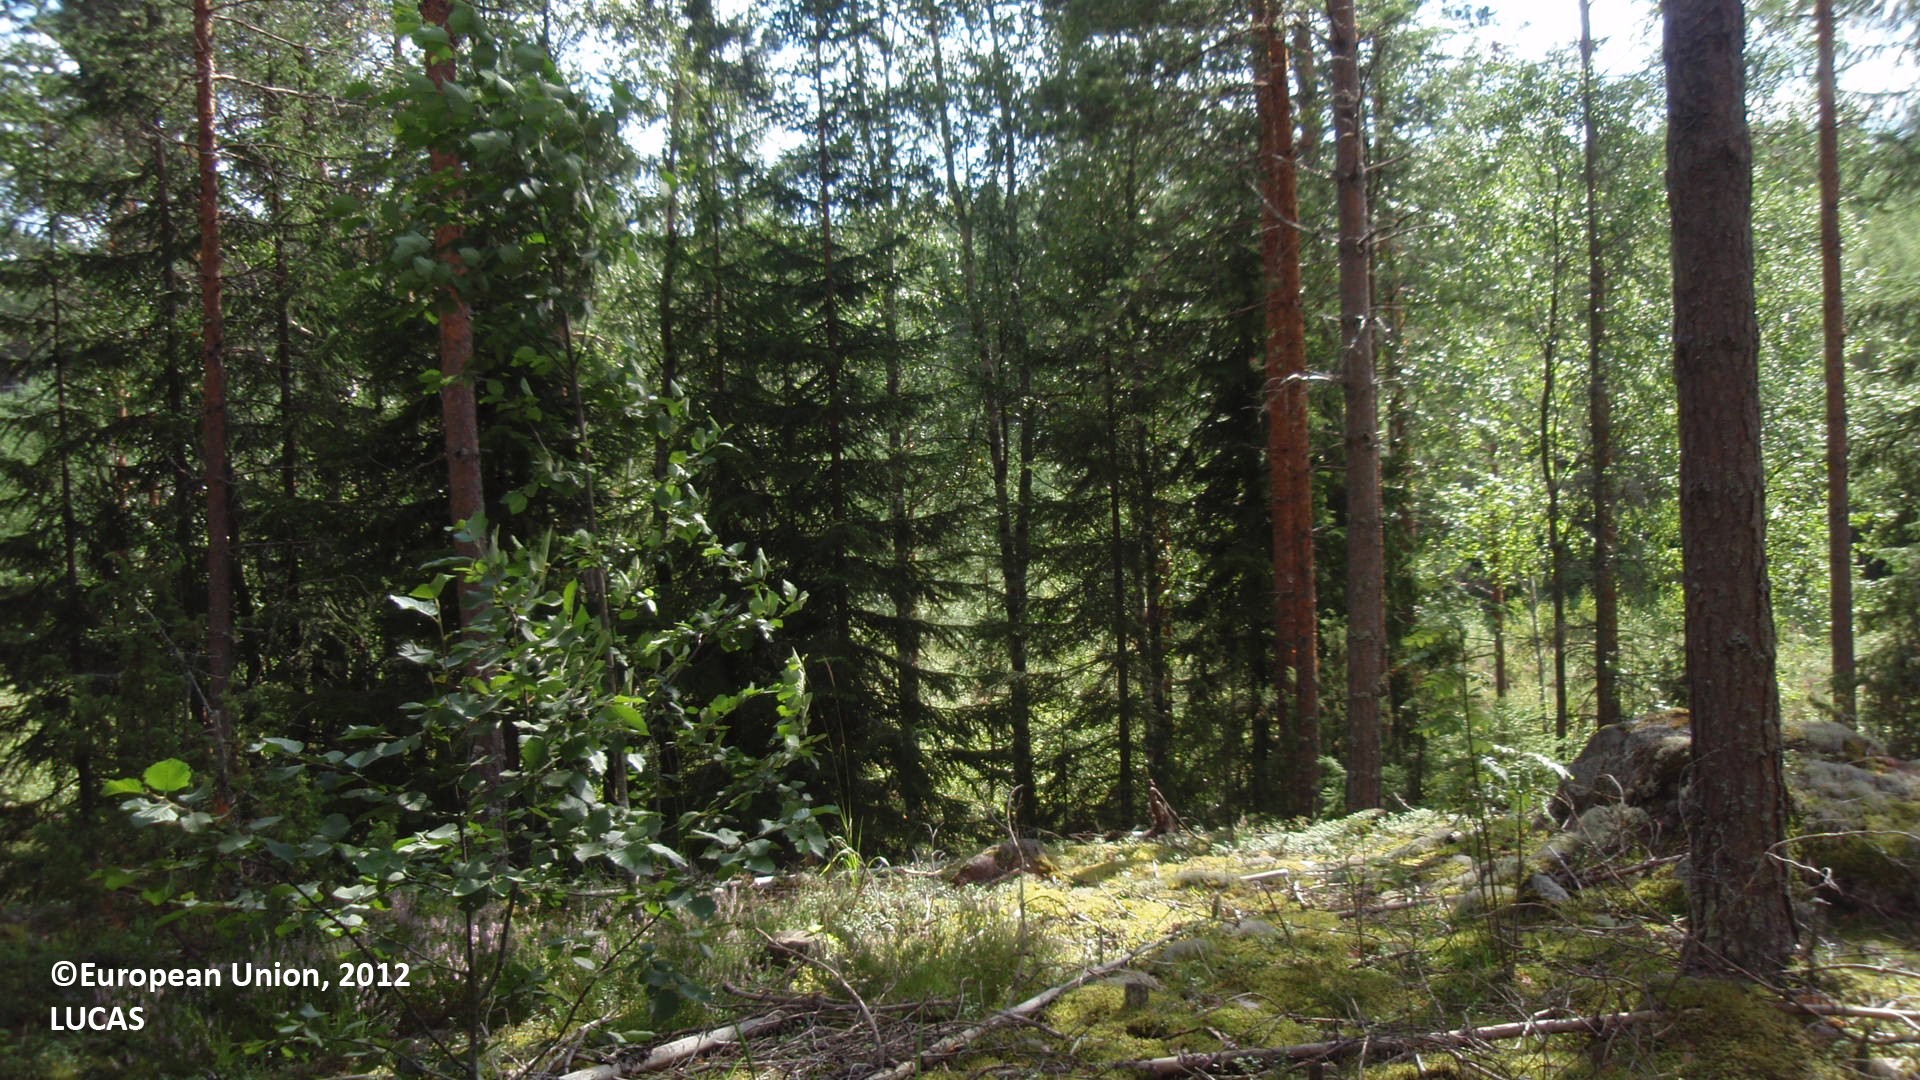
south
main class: Woodland
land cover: Pine dominated coniferous woodland
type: boreal forest
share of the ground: 50 - 75 %
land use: Forestry
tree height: > 5 m
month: August
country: FI
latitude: 61.1539
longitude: 27.7478
